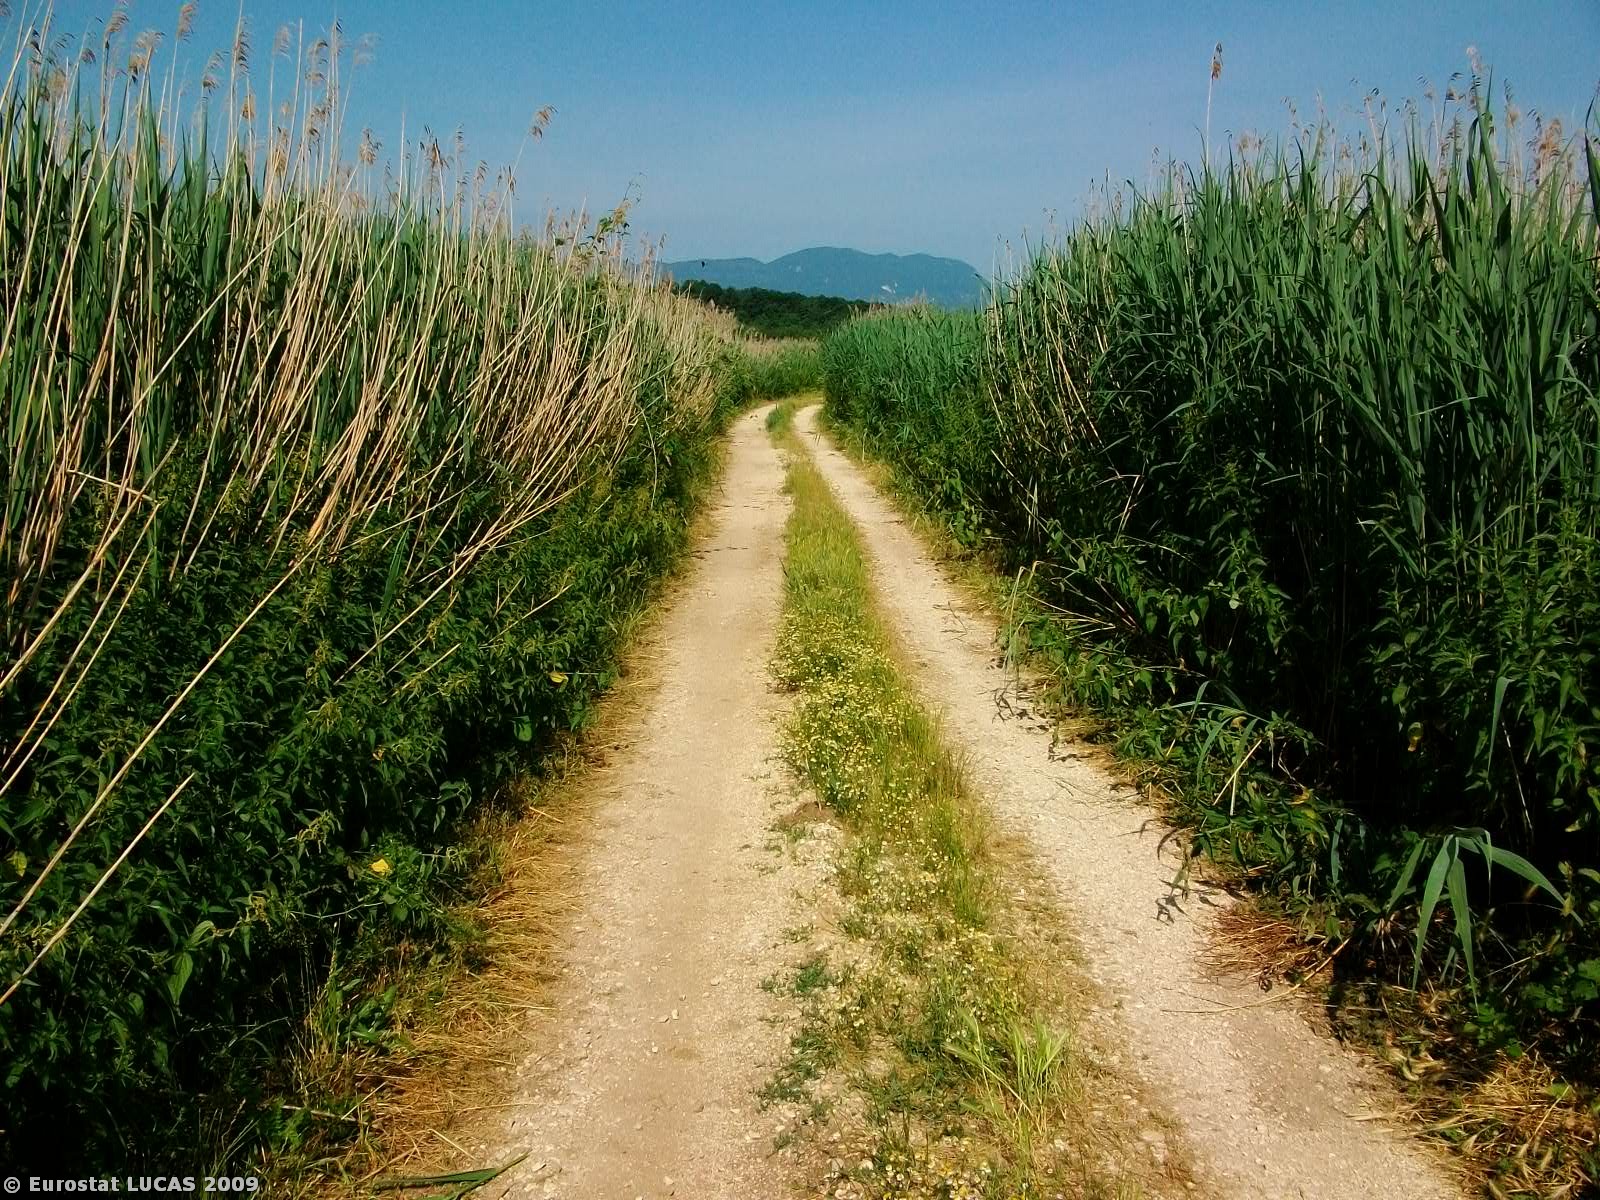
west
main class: Wetlands
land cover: Inland marshes
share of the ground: > 75 %
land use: Unused
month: May
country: GR
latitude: 39.8730
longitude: 20.6070
